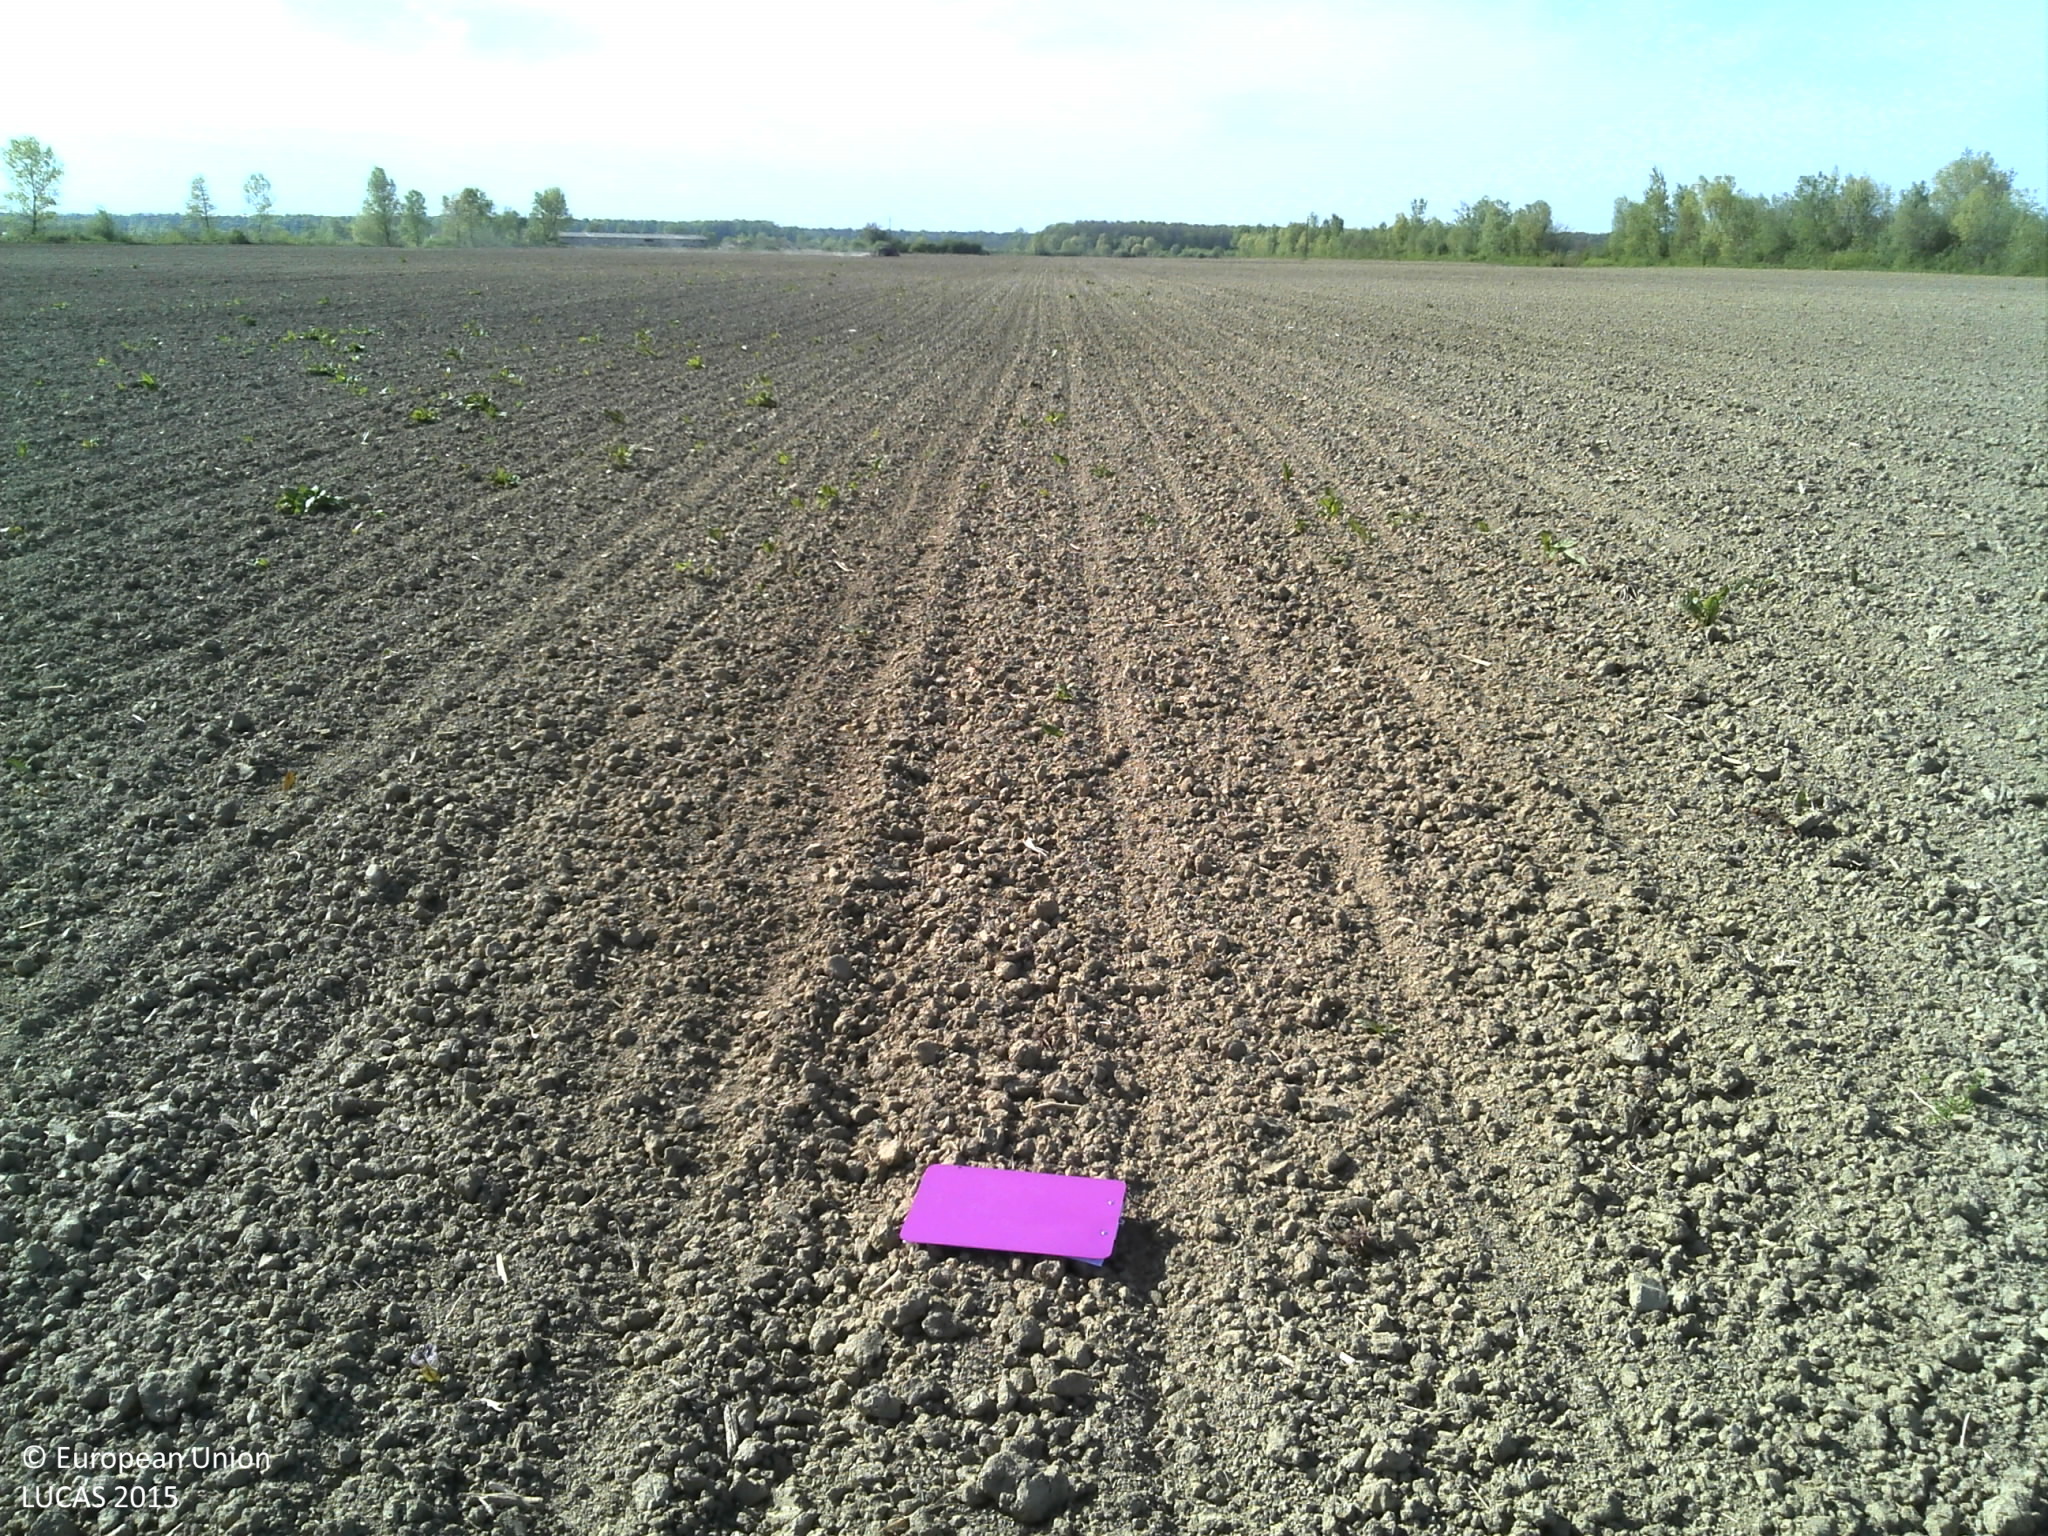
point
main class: Cropland
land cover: Soya
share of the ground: < 10 %
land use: Agriculture (excluding fallow land and kitchen gardens)
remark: Tilled/Sowed
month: April
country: HR
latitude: 44.9274
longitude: 18.9131
